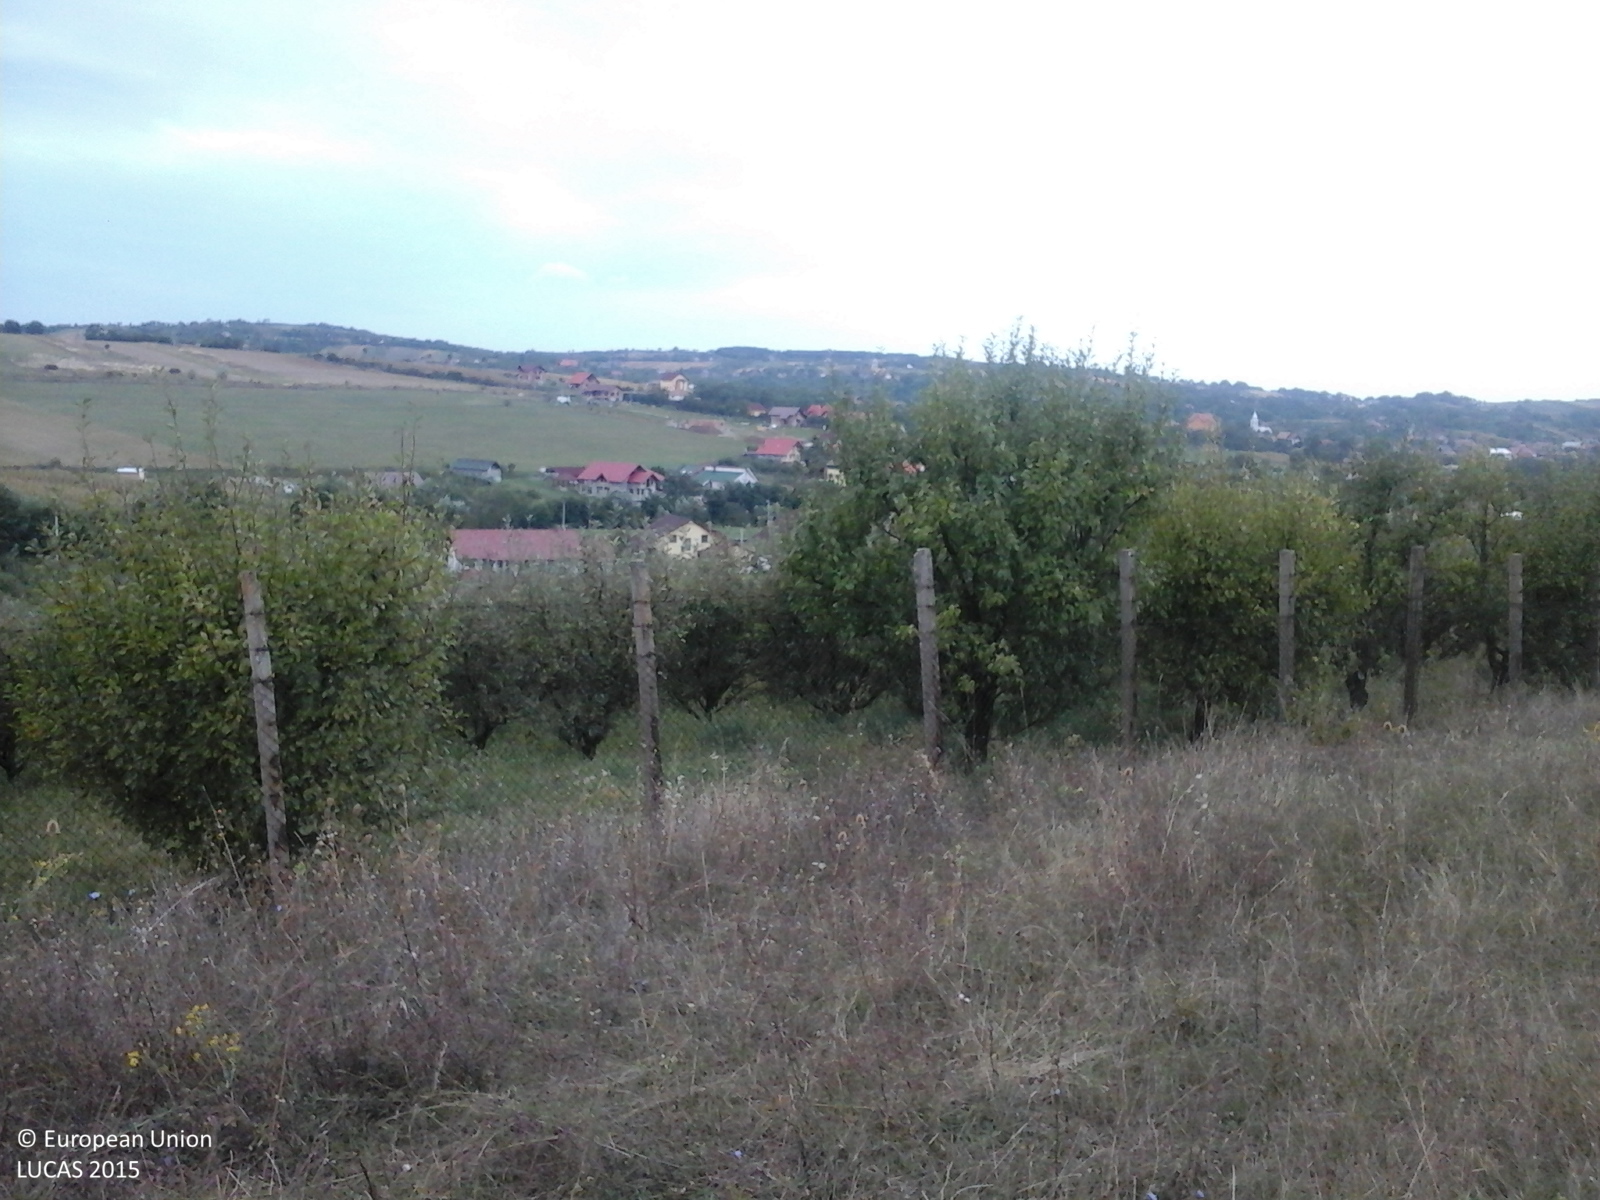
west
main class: Shrubland
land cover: Shrubland with sparse tree cover
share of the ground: > 75 %
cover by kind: herbaceous plants 65 %, shrubs 30 %, broadleaved forest trees 5 %
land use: Fallow land
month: September
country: RO
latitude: 47.1547
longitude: 23.0286
